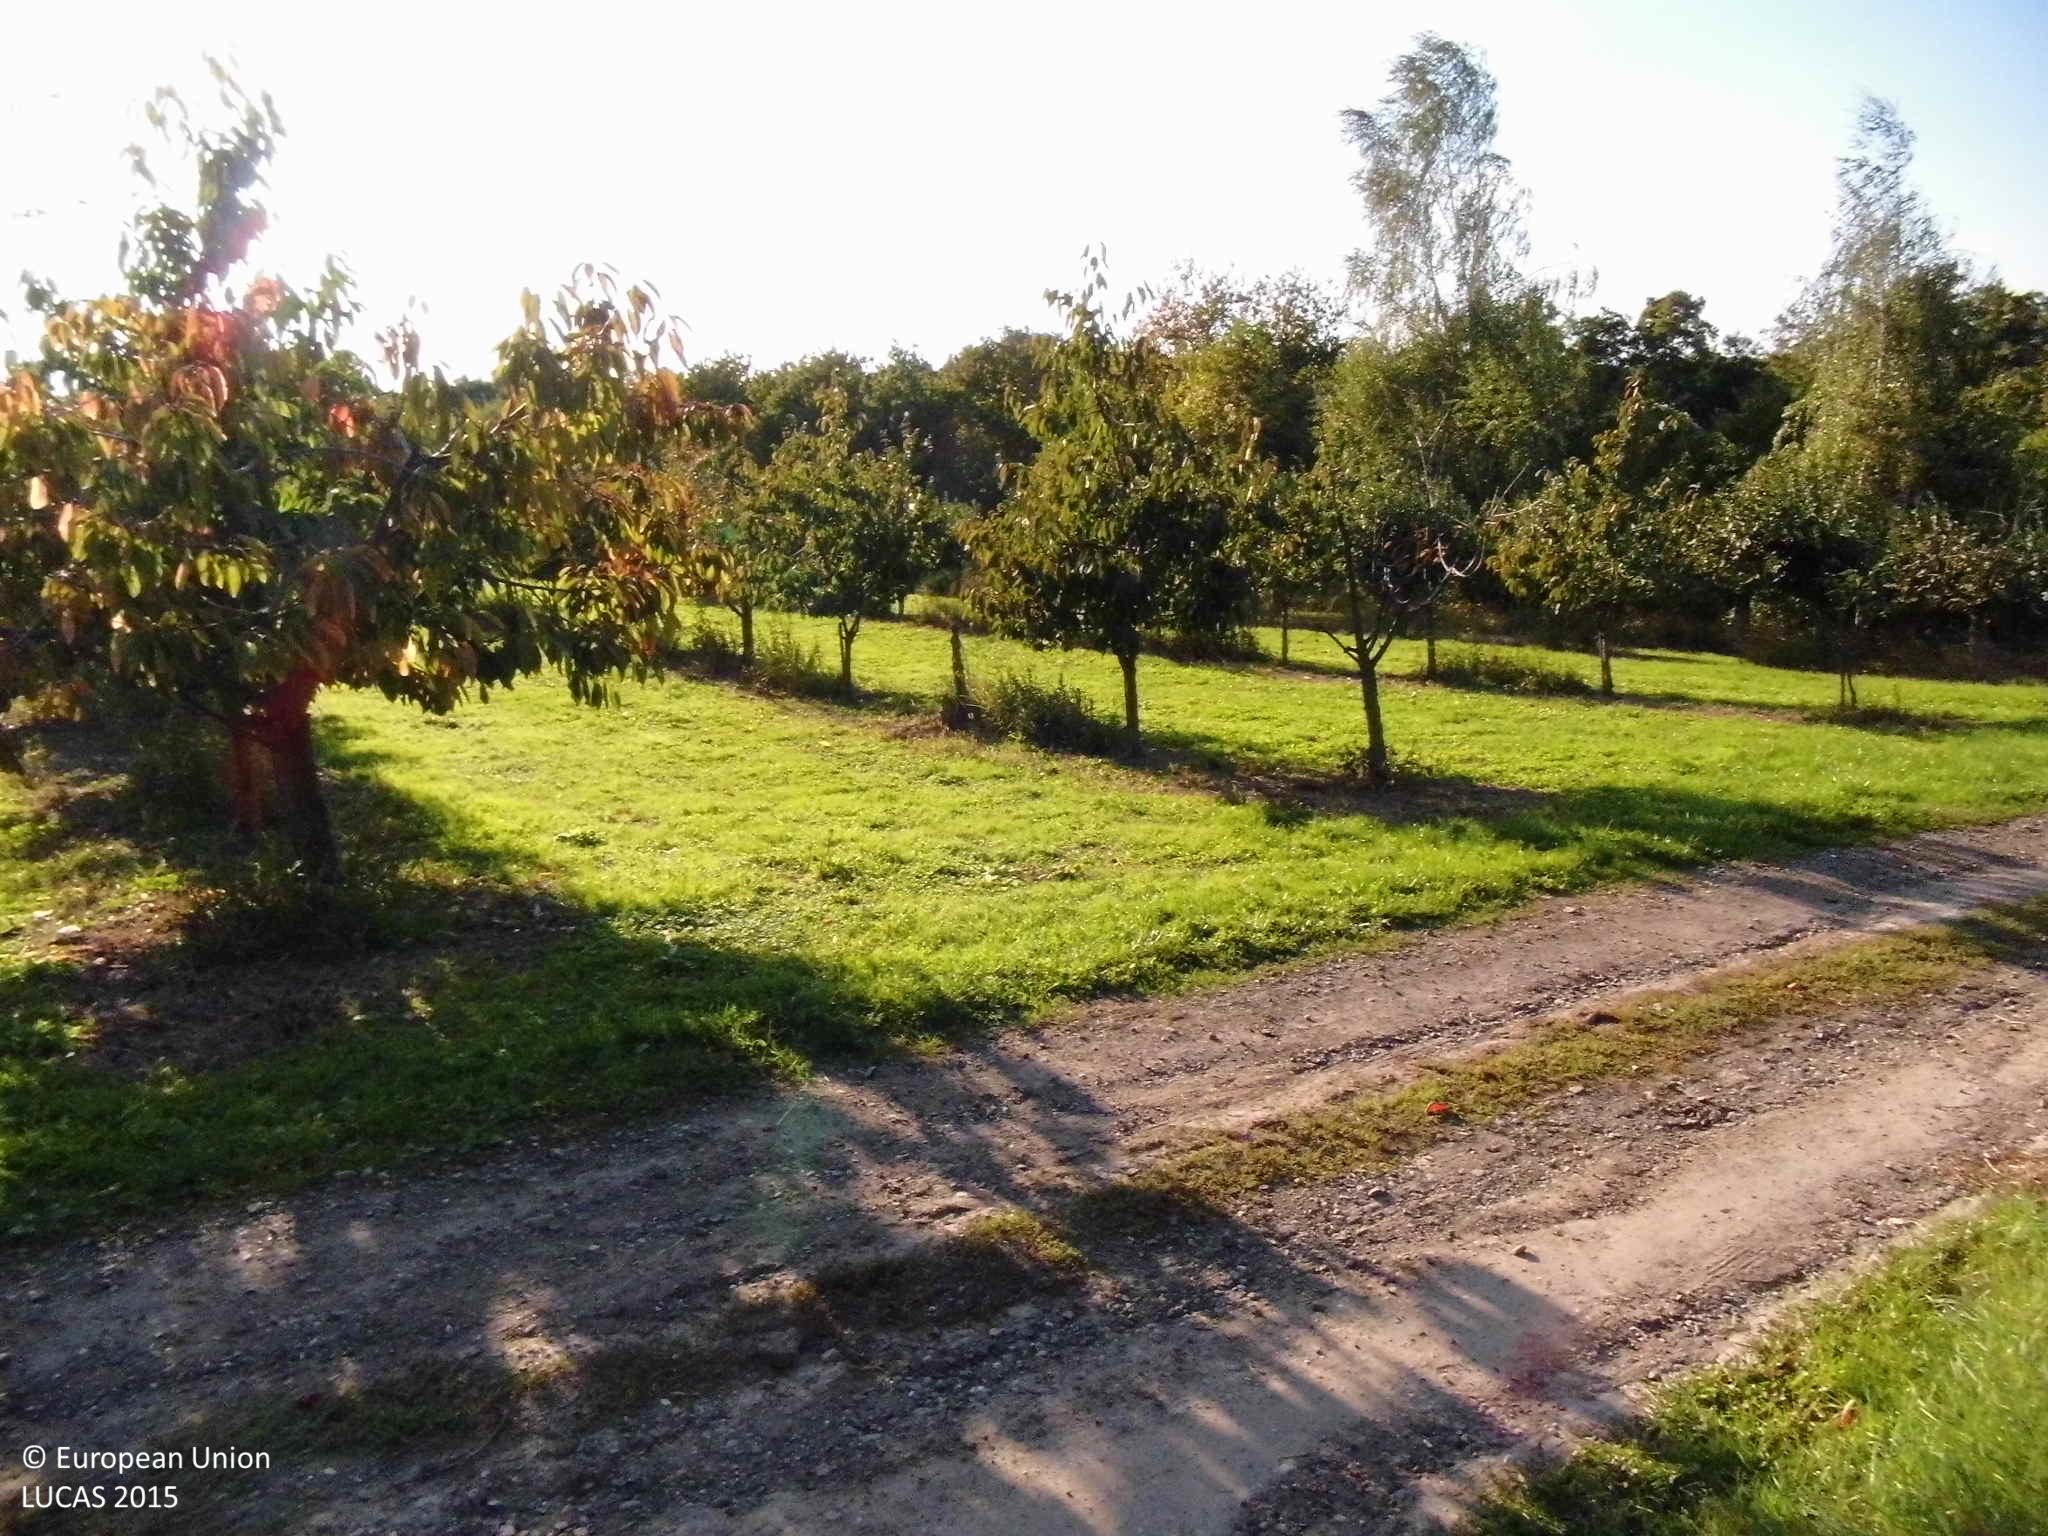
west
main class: Cropland
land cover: Cherry fruit
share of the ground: 25 - 50 %
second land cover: Grassland without tree/shrub cover
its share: > 75 %
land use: Agriculture (excluding fallow land and kitchen gardens)
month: September
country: DE
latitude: 50.3724
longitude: 7.4835
